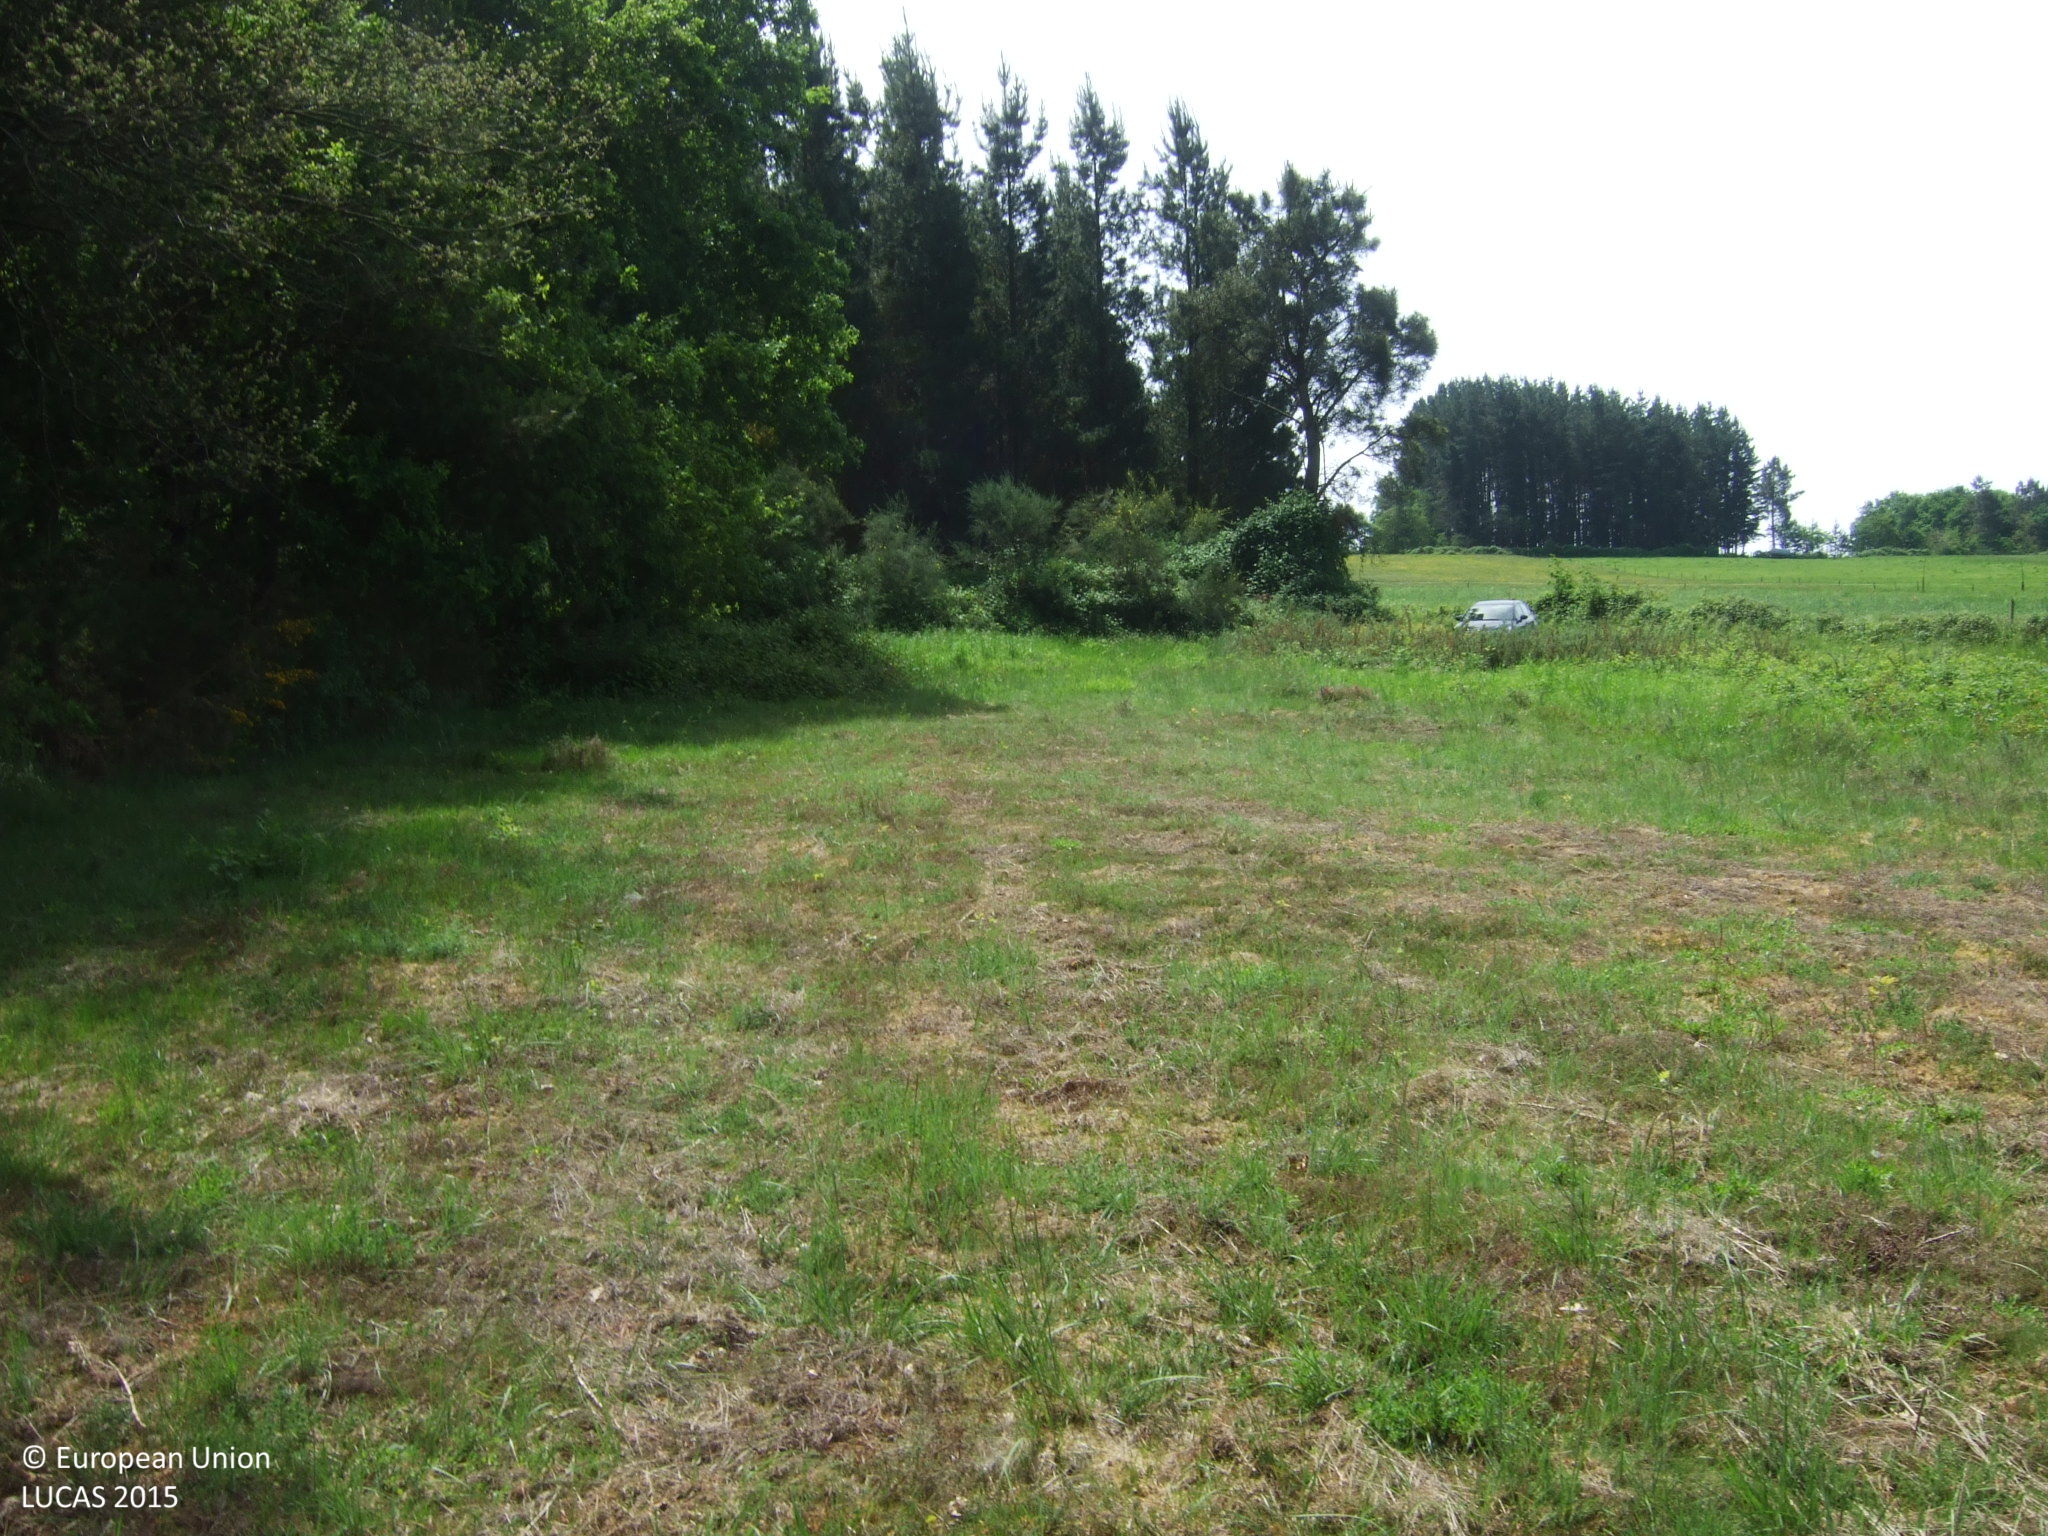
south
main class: Grassland
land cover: Grassland without tree/shrub cover
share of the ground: > 75 %
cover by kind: herbaceous plants 100 %
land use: Agriculture (excluding fallow land and kitchen gardens)
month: May
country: ES
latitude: 42.8856
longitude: -7.3966
